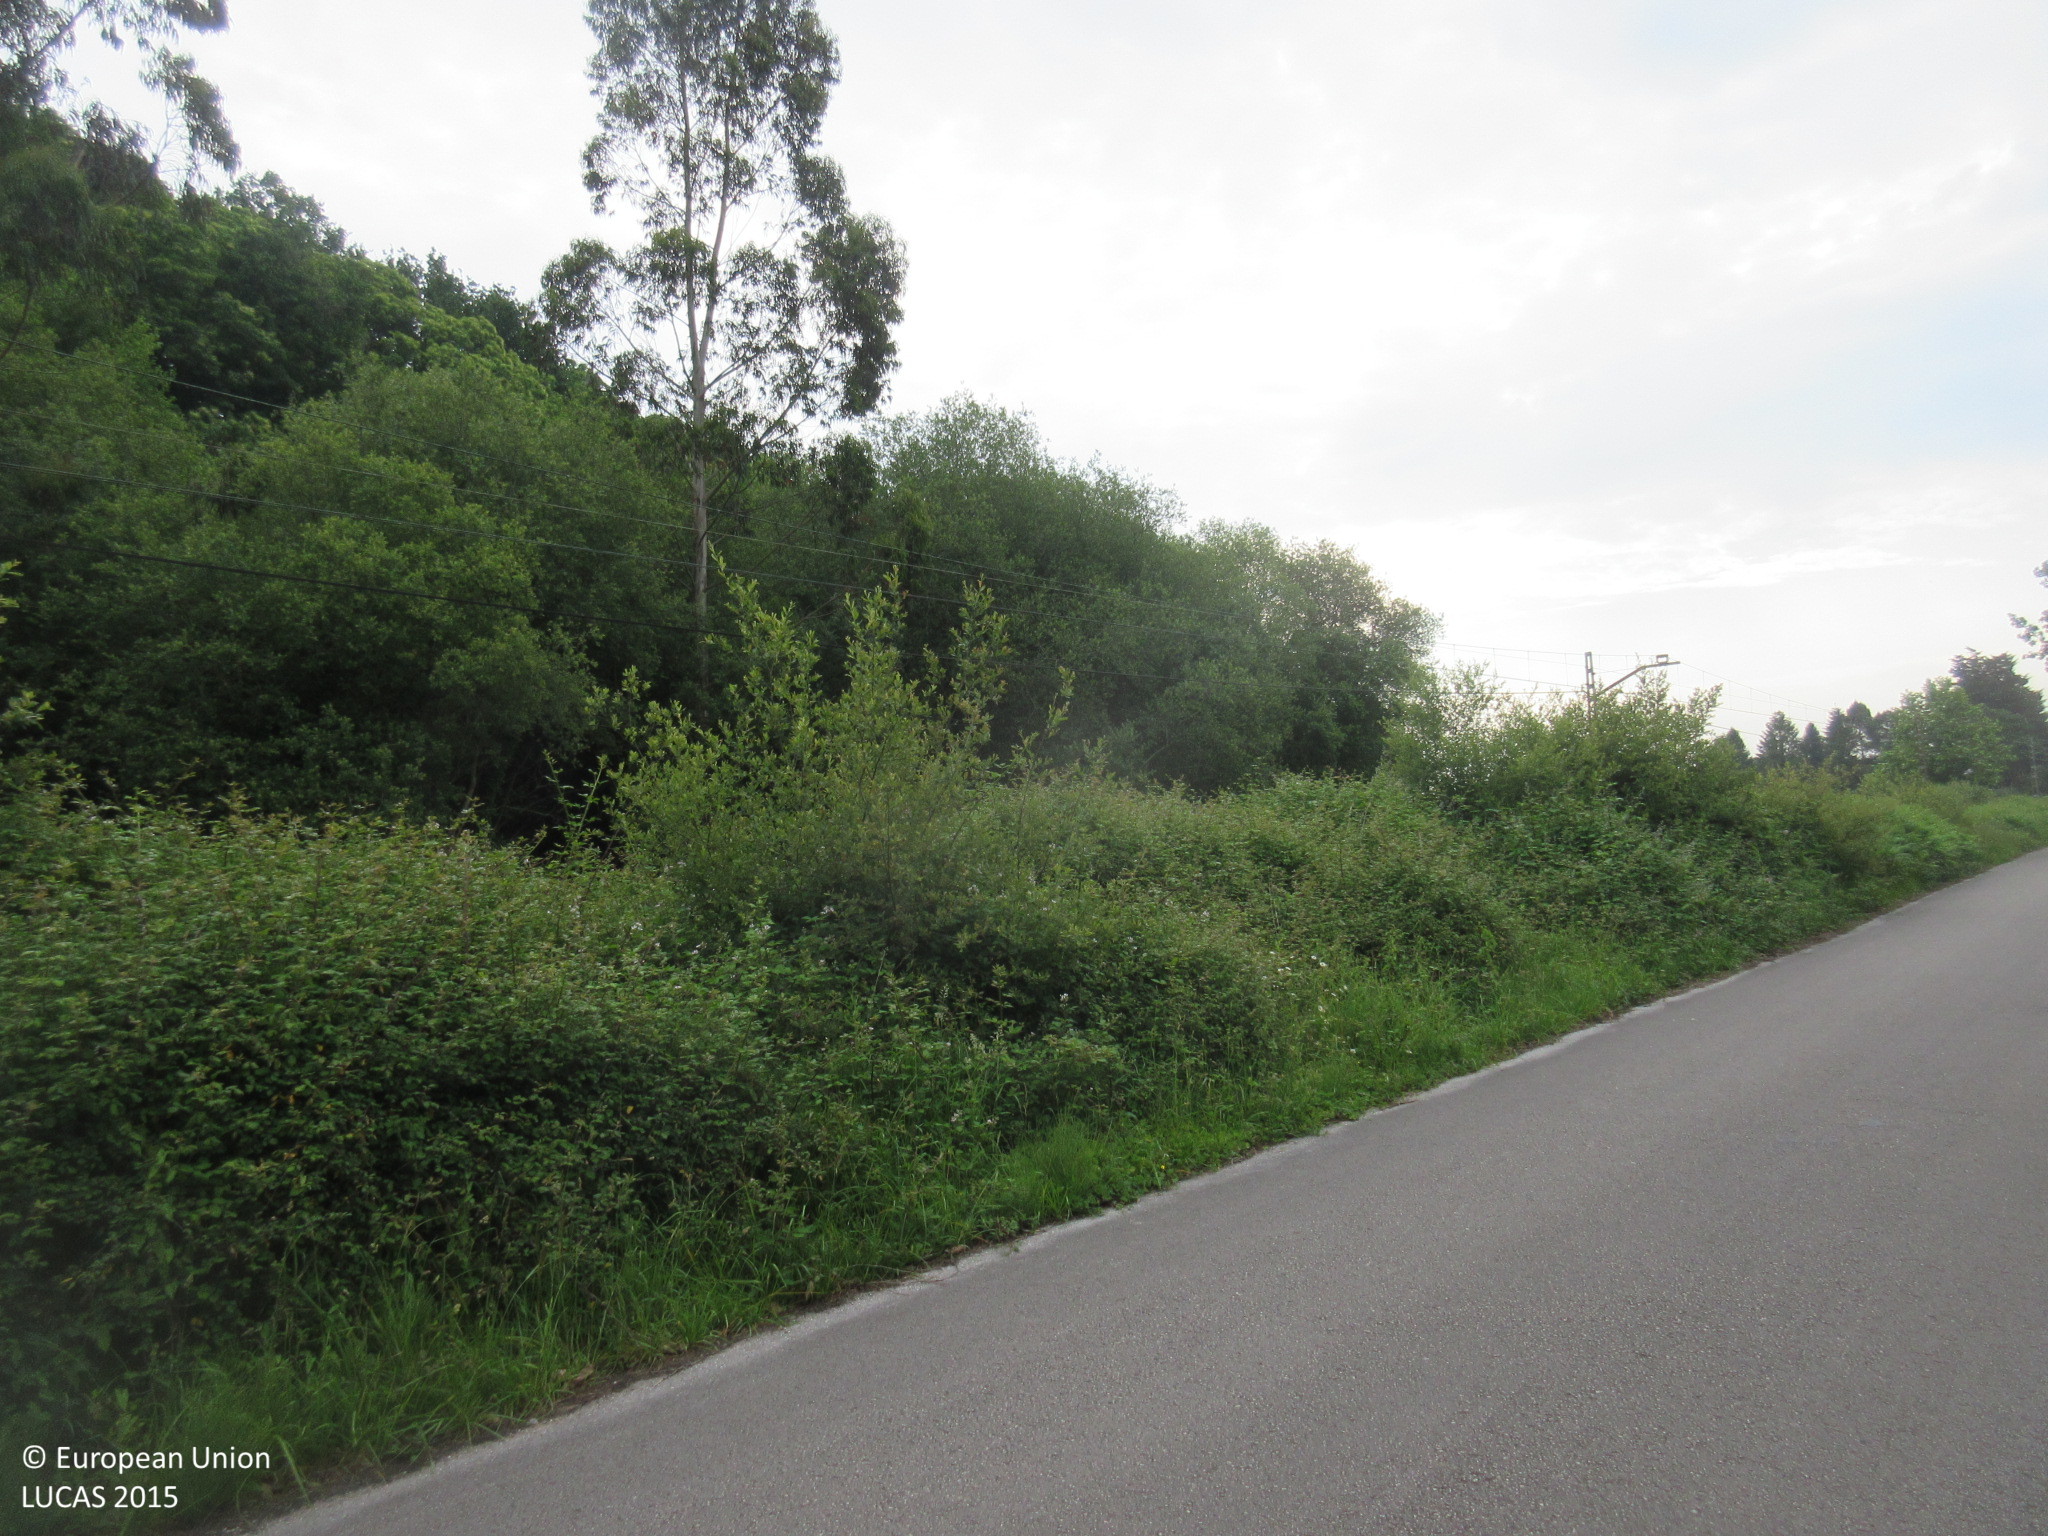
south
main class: Grassland
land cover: Grassland without tree/shrub cover
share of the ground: > 75 %
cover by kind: herbaceous plants 100 %
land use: Agriculture (excluding fallow land and kitchen gardens)
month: June
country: ES
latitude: 43.3594
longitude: -4.1323
